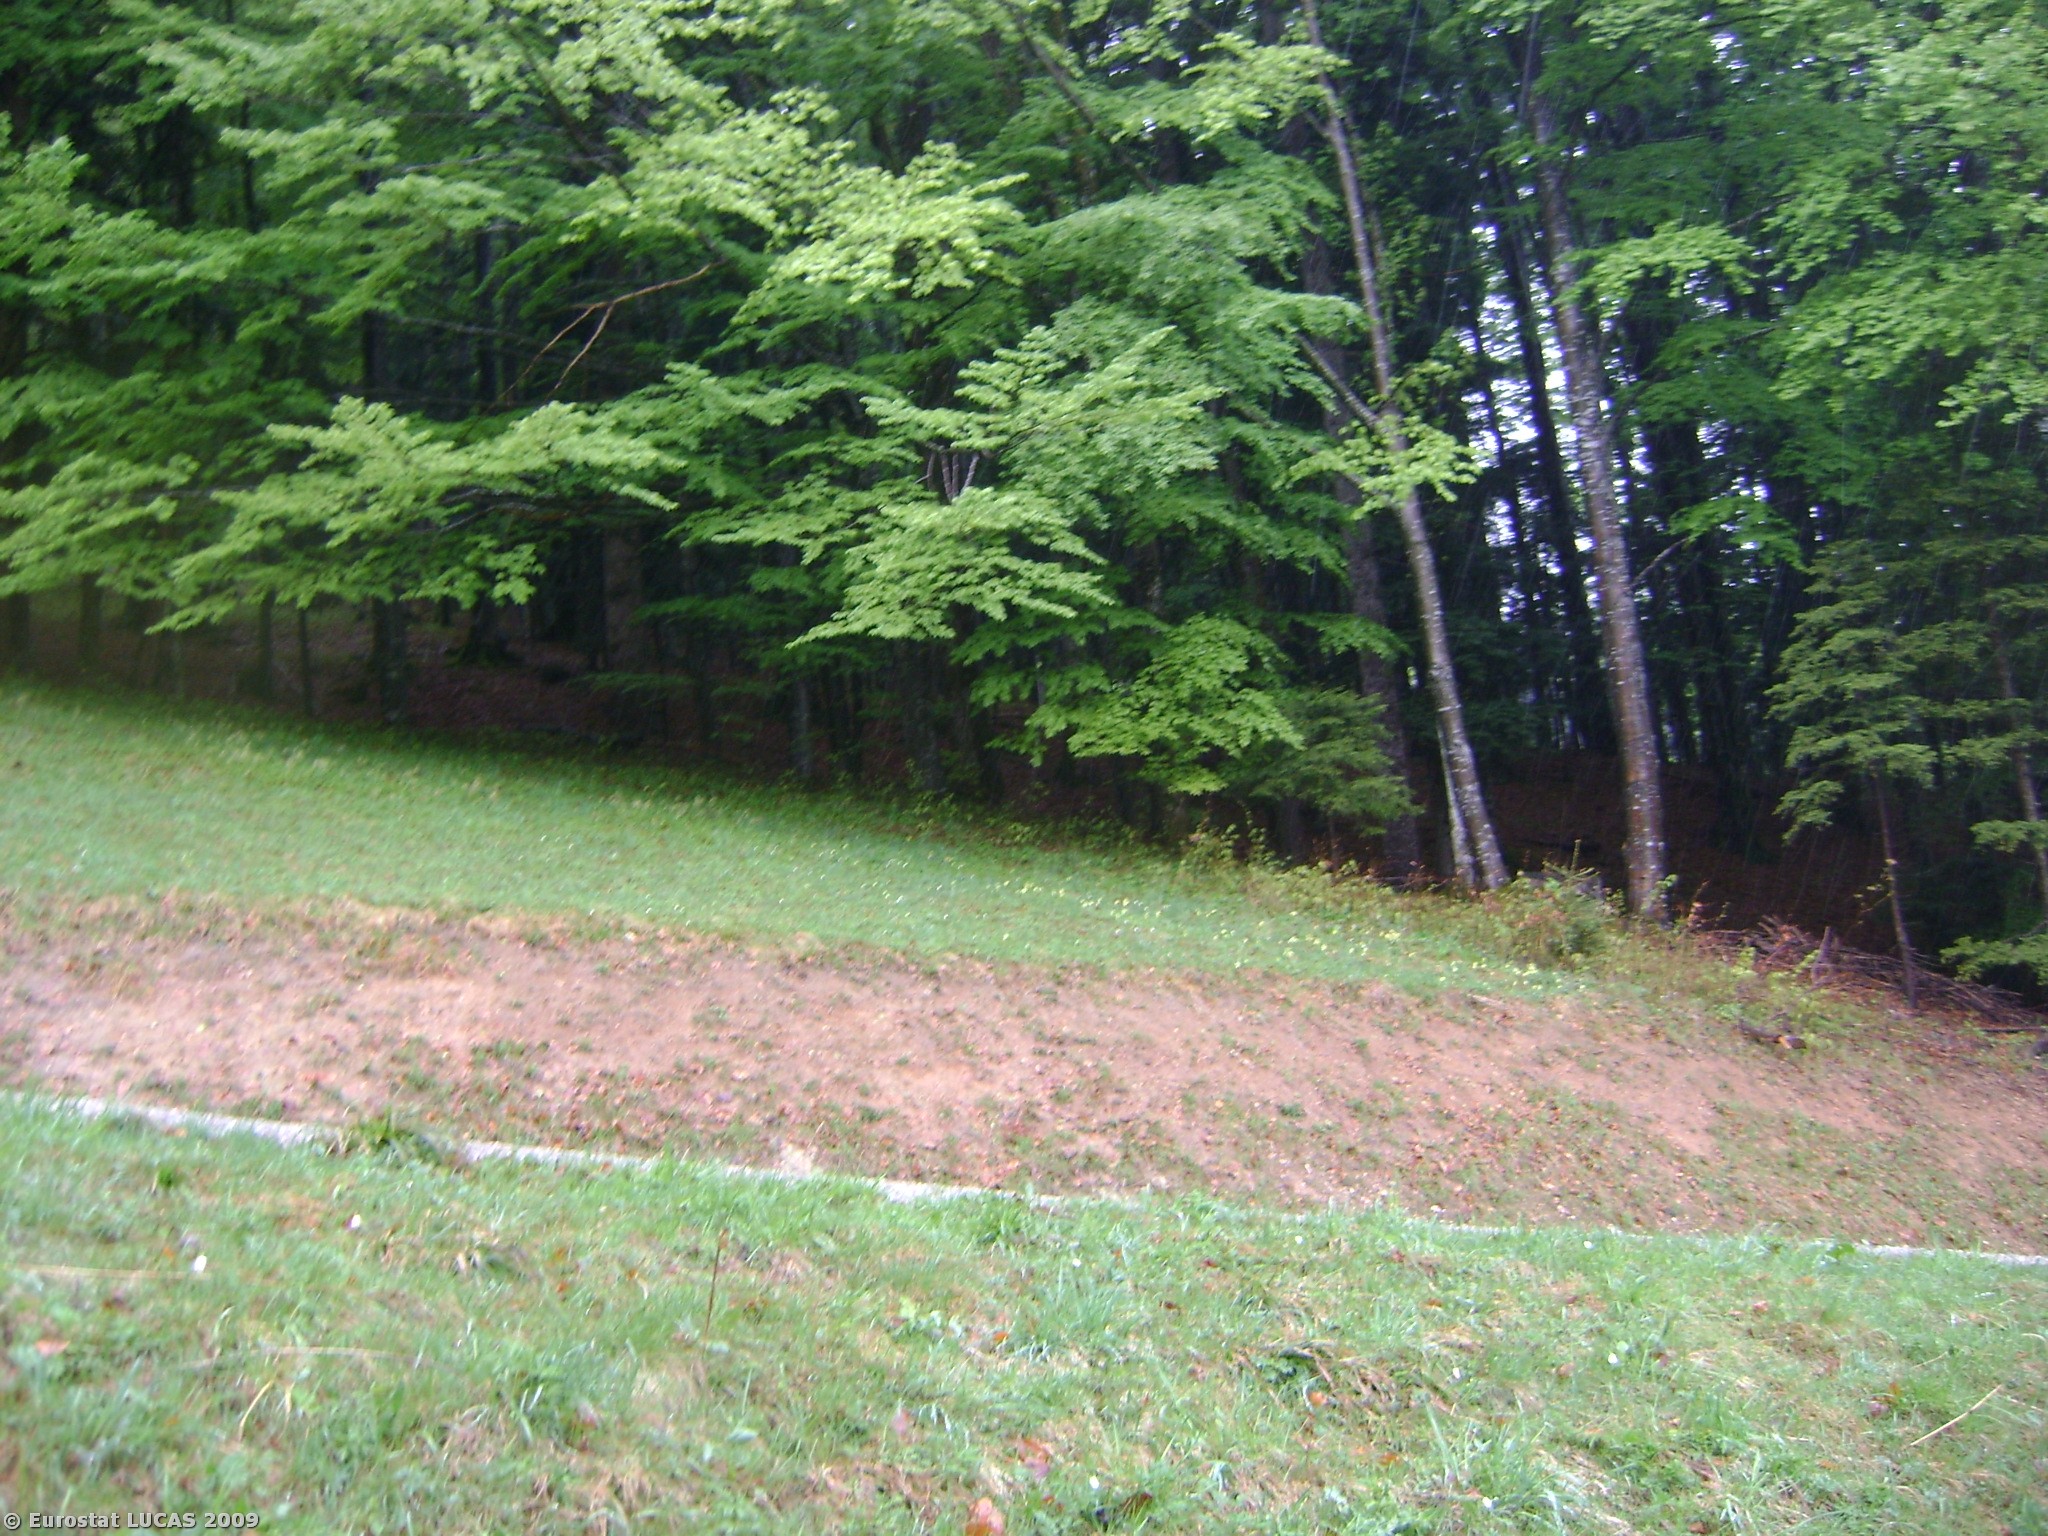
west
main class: Grassland
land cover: Grassland without tree/shrub cover
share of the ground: > 75 %
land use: Agriculture (excluding fallow land and kitchen gardens)
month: May
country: AT
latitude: 47.7976
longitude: 13.2429
